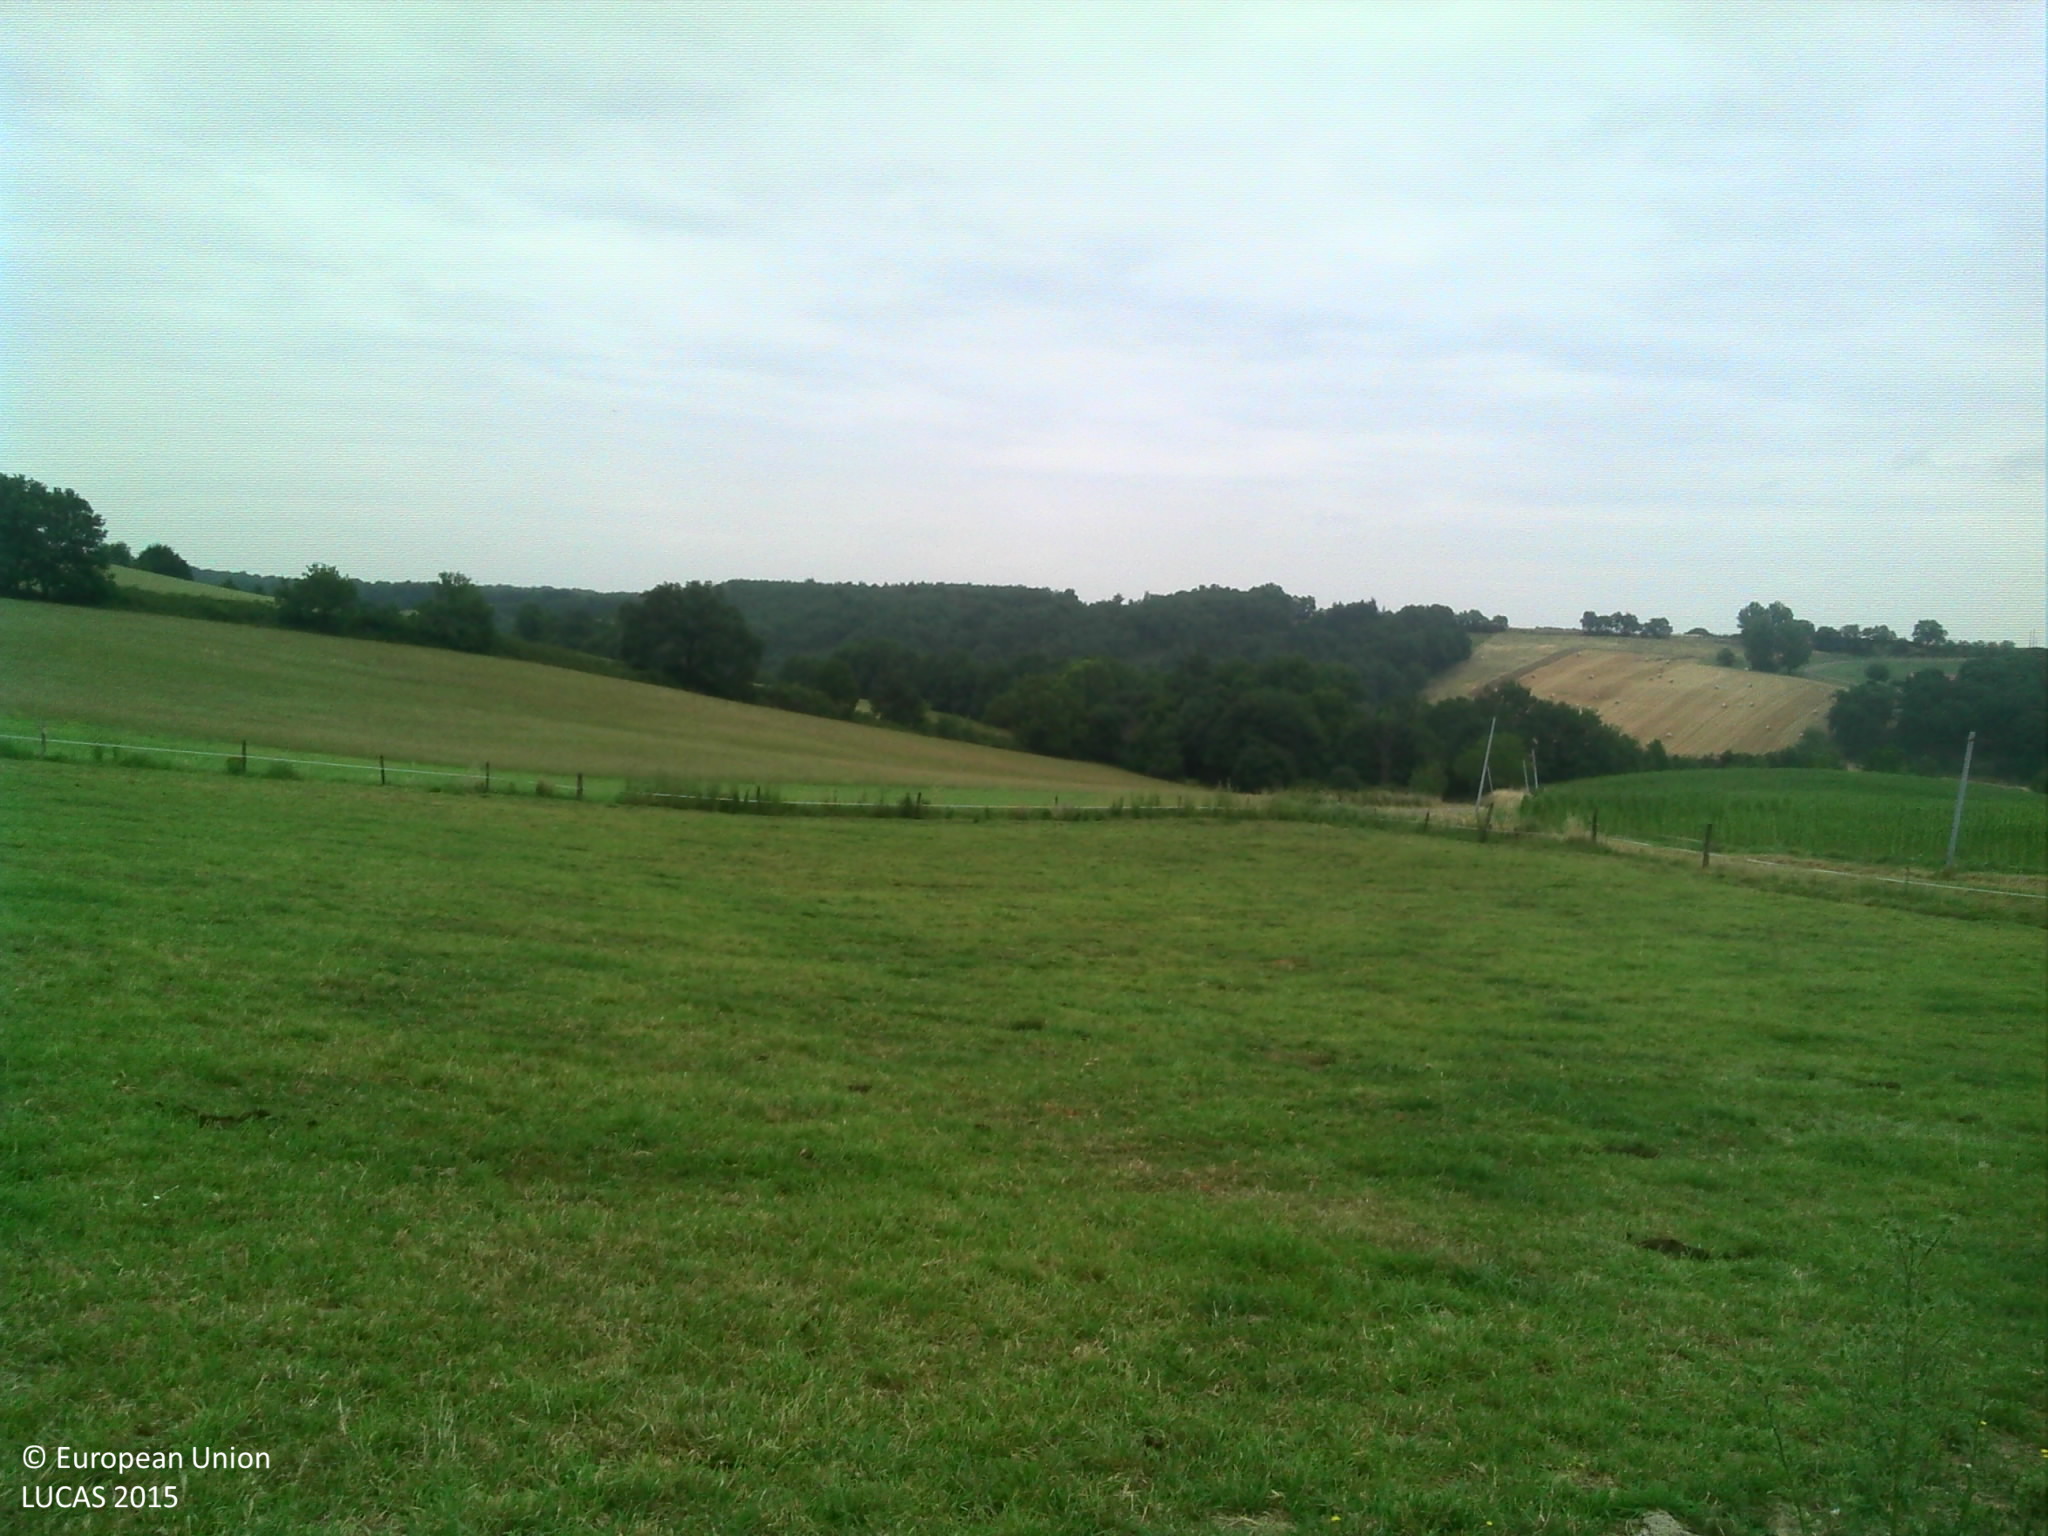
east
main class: Grassland
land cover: Grassland without tree/shrub cover
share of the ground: > 75 %
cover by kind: herbaceous plants 100 %
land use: Agriculture (excluding fallow land and kitchen gardens)
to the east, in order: Grassland without tree/shrub cover; Fences; Grassland without tree/shrub cover; Fences; Grassland without tree/shrub cover; Managed hedges; Temporary grasslands
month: July
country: FR
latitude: 44.0250
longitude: 0.9274
